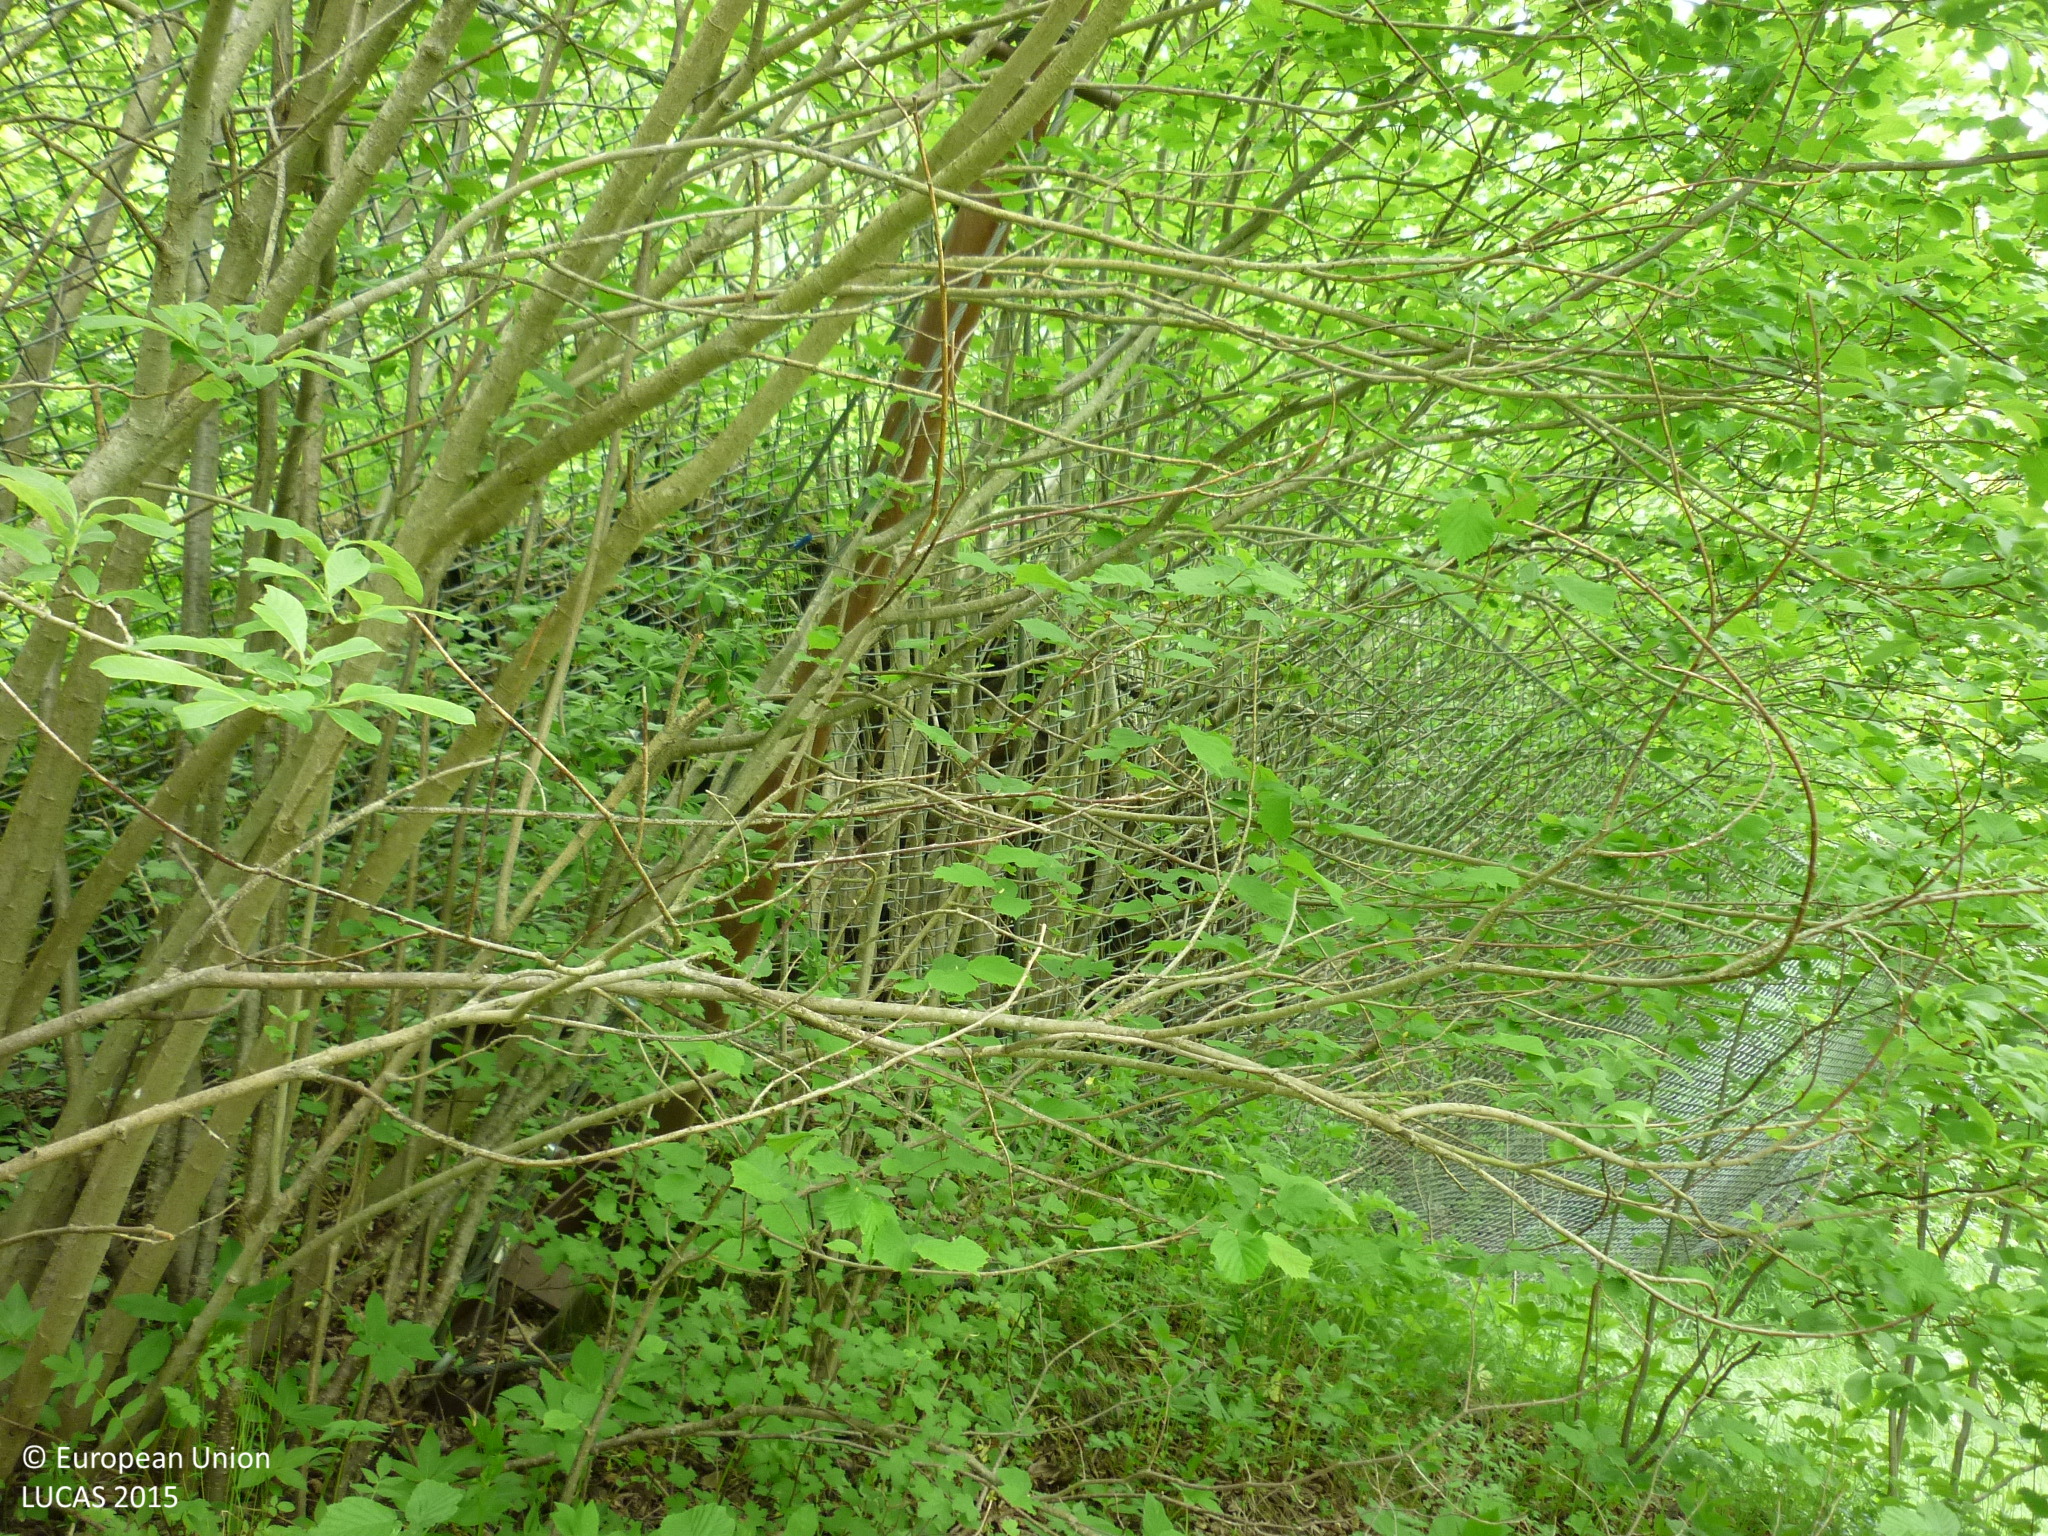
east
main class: Shrubland
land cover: Shrubland with sparse tree cover
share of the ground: 50 - 75 %
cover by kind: shrubs 50 %, herbaceous plants 25 %, consolidated bare surface 10 %, unconsolidated bare surface 10 %, coniferous forest trees 5 %
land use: Semi-natural and natural areas not in use
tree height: > 5 m
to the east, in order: Shrubland with sparse tree cover; Broadleaved woodland; Grassland with sparse tree/shrub cover
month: June
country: AT
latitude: 47.3234
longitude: 14.4312
